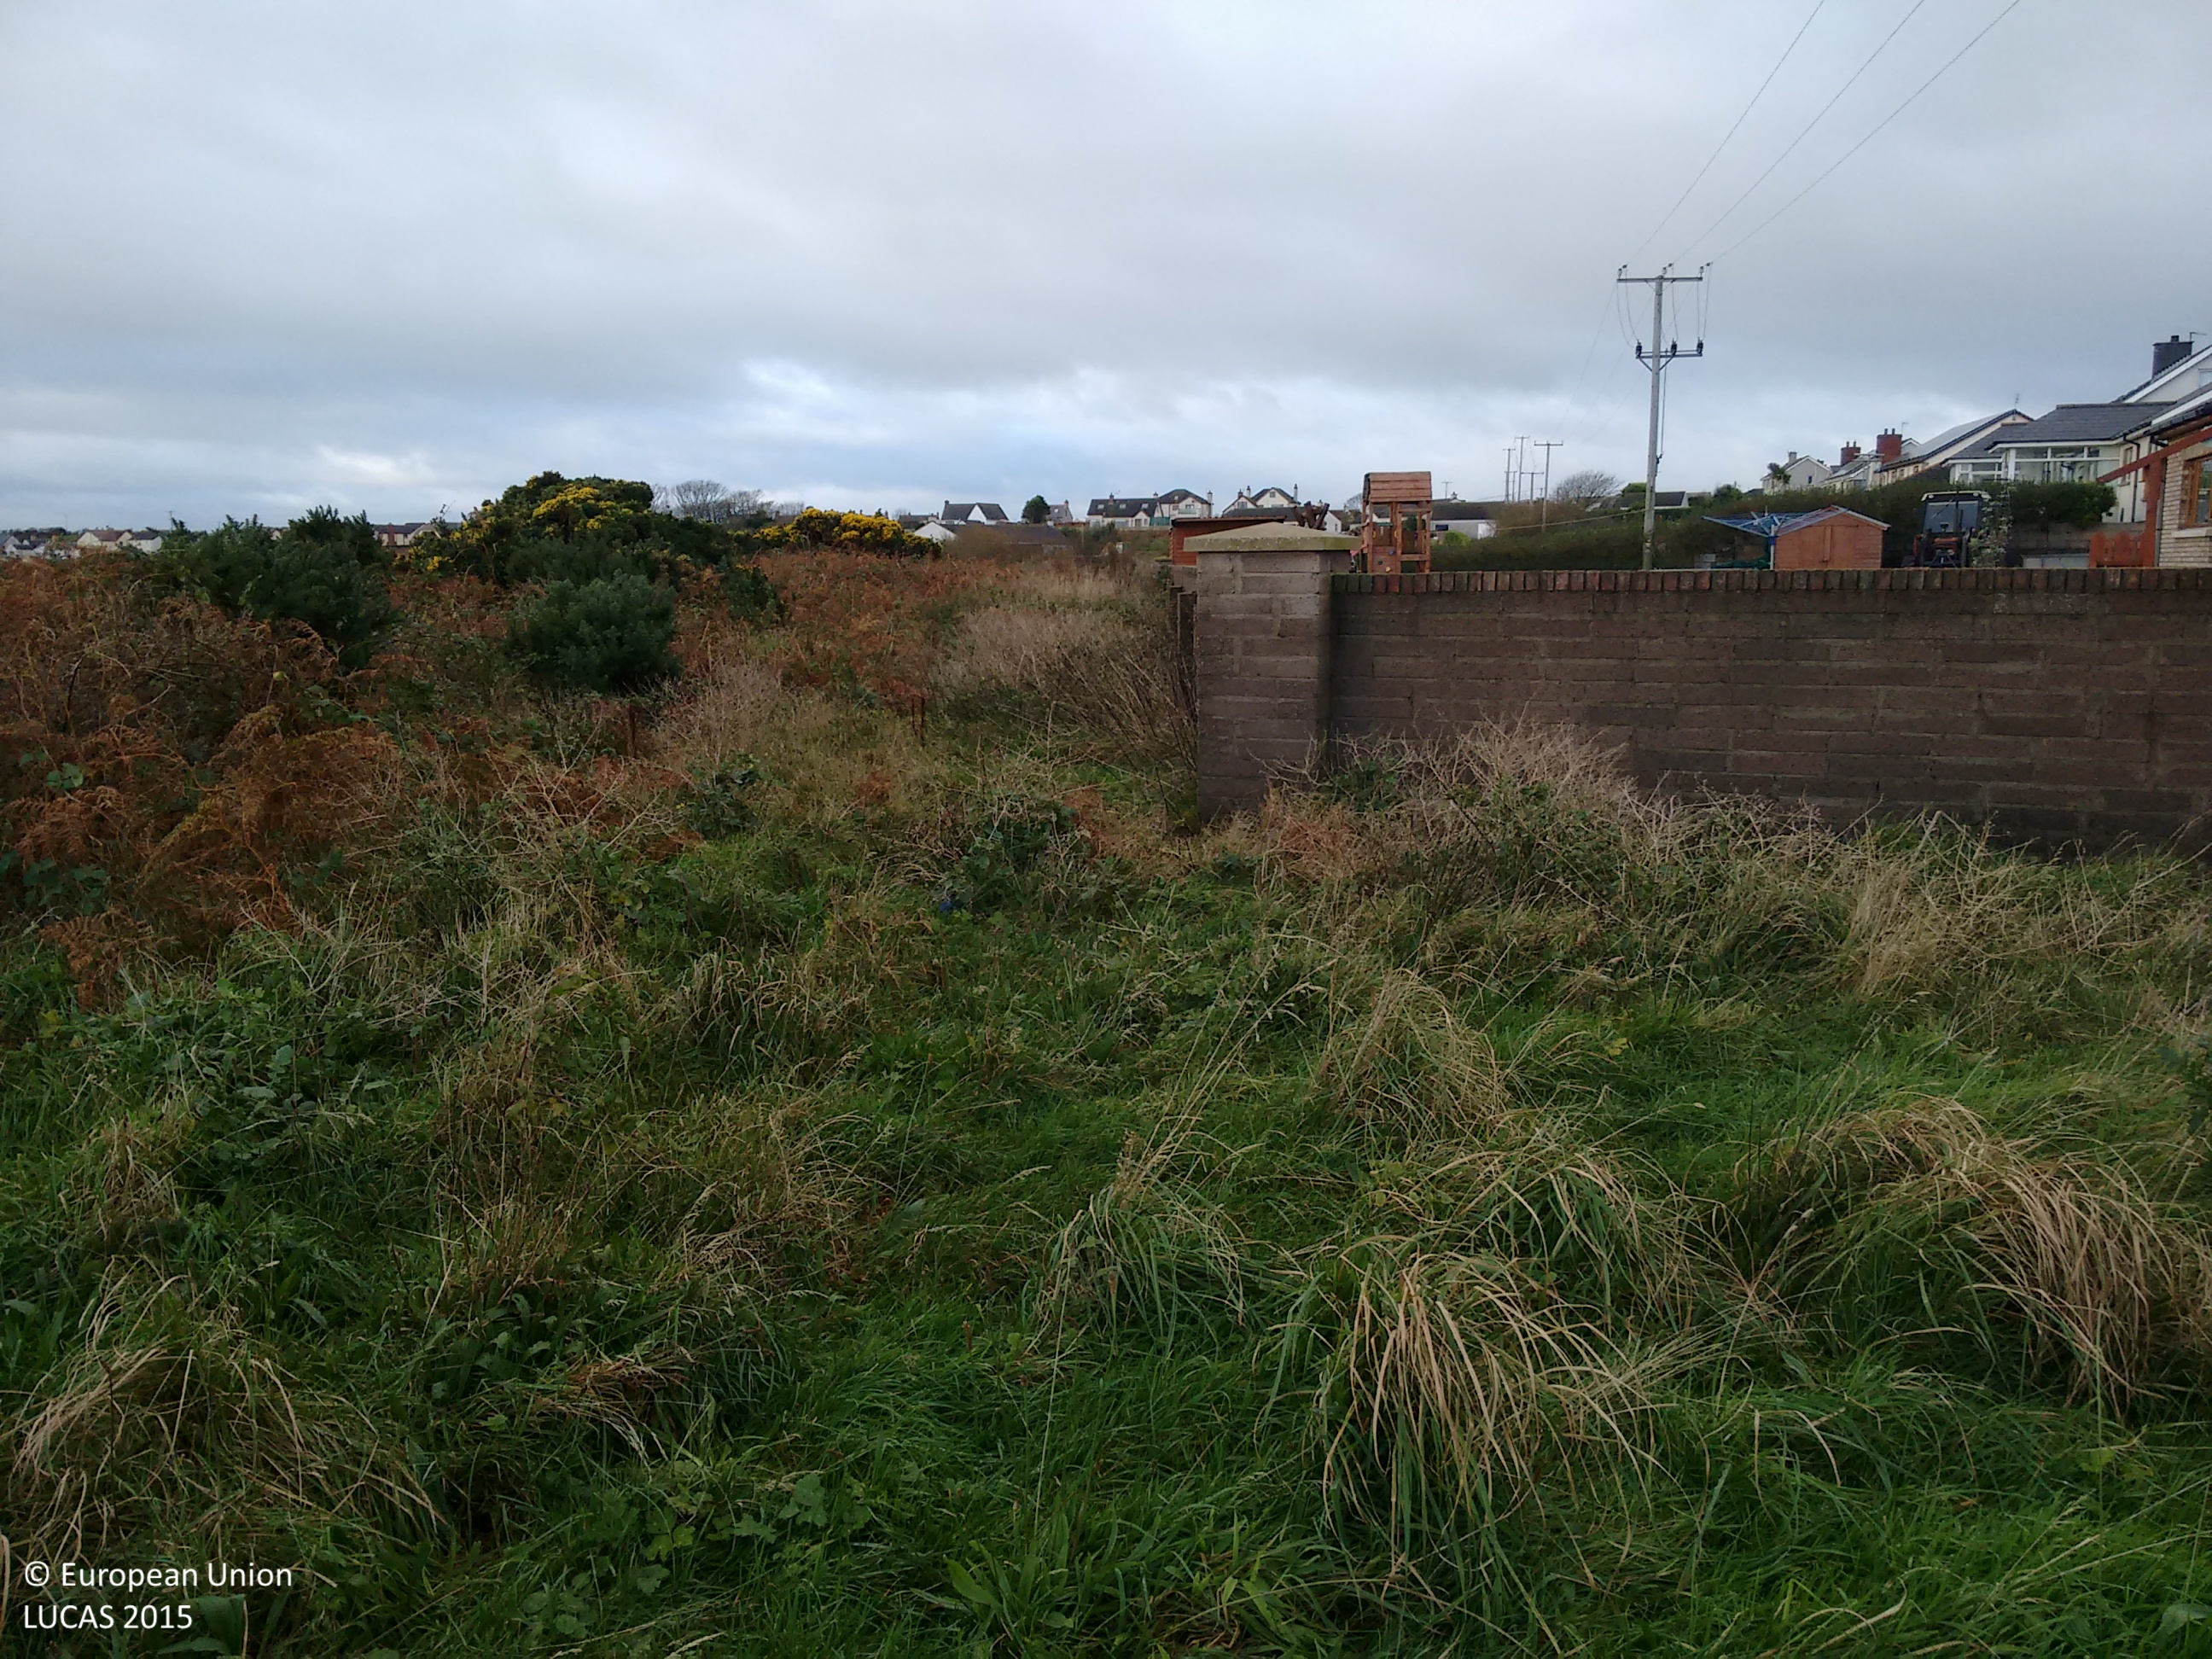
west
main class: Grassland
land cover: Grassland without tree/shrub cover
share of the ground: > 75 %
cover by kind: herbaceous plants 100 %
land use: Agriculture (excluding fallow land and kitchen gardens)
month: November
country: GB
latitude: 54.4558
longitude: -5.4428
